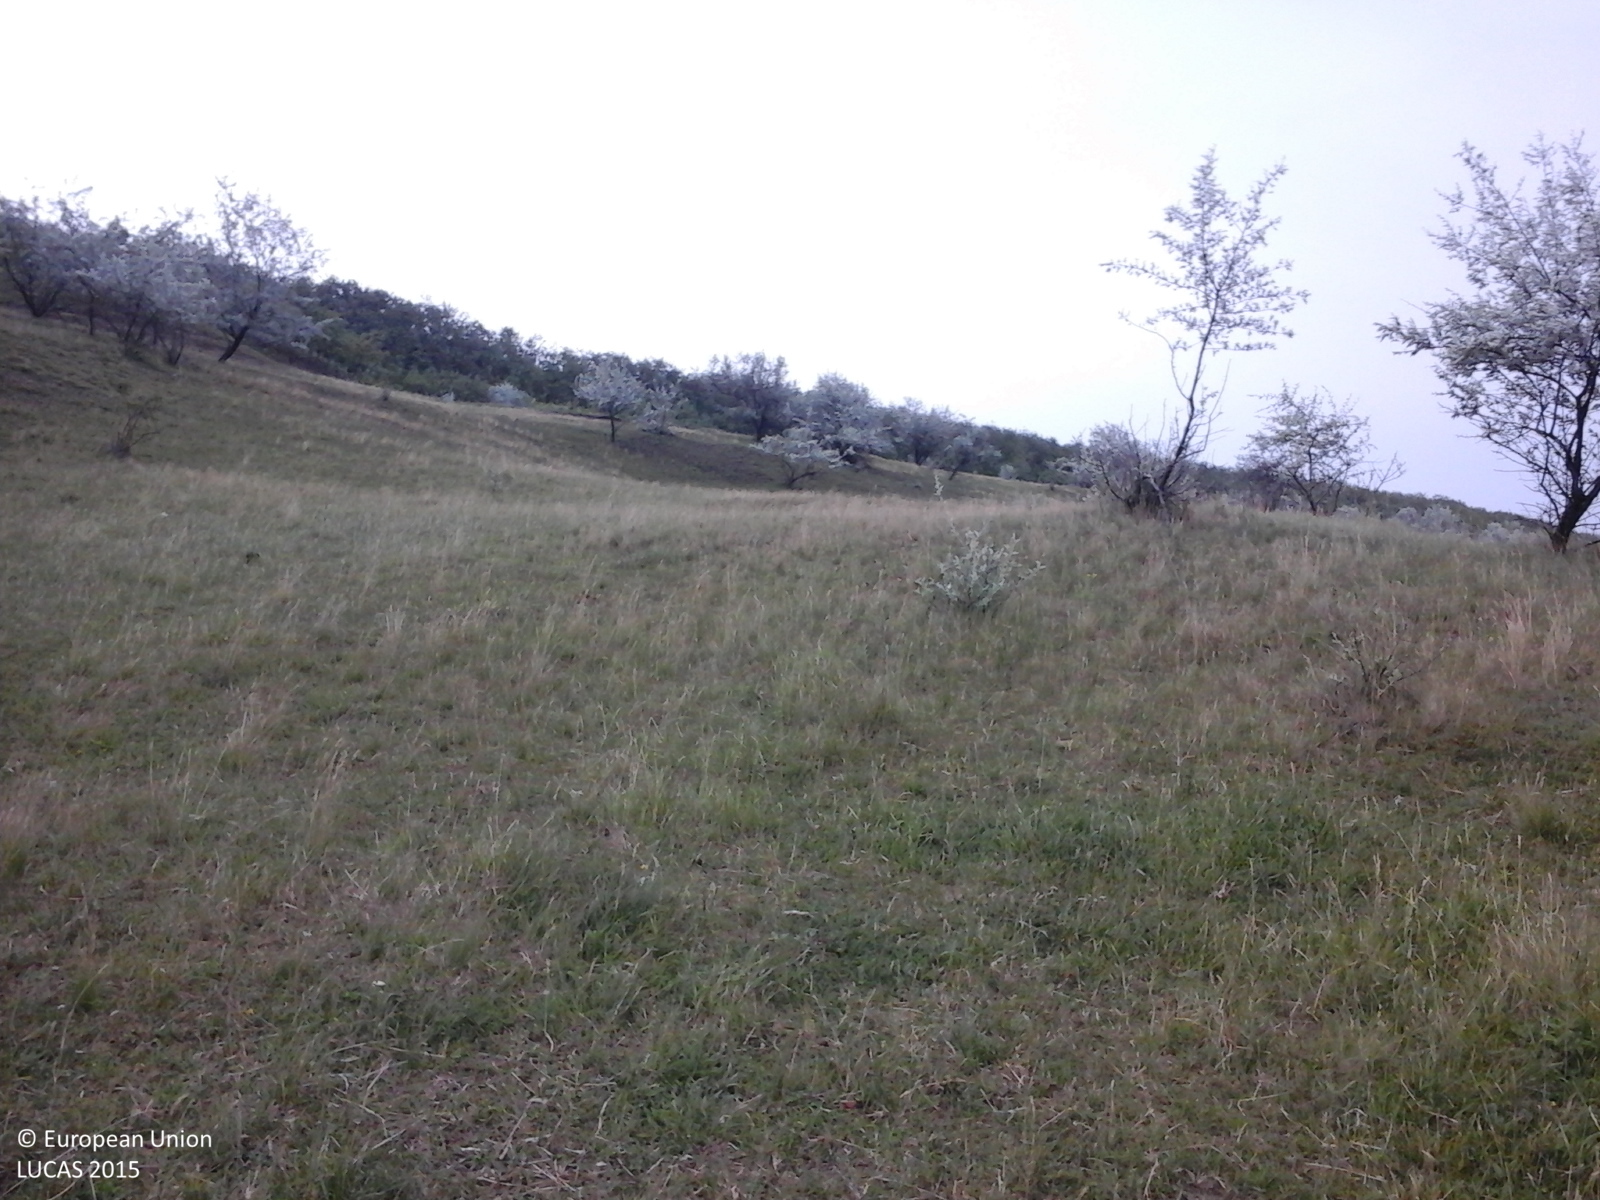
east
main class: Grassland
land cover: Grassland with sparse tree/shrub cover
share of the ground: > 75 %
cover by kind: herbaceous plants 85 %, shrubs 10 %, broadleaved forest trees 5 %
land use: Agriculture (excluding fallow land and kitchen gardens)
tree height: < 5 m
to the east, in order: Grassland with sparse tree/shrub cover; Broadleaved woodland; Maize; Lucerne
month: June
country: RO
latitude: 47.8574
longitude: 26.5734
